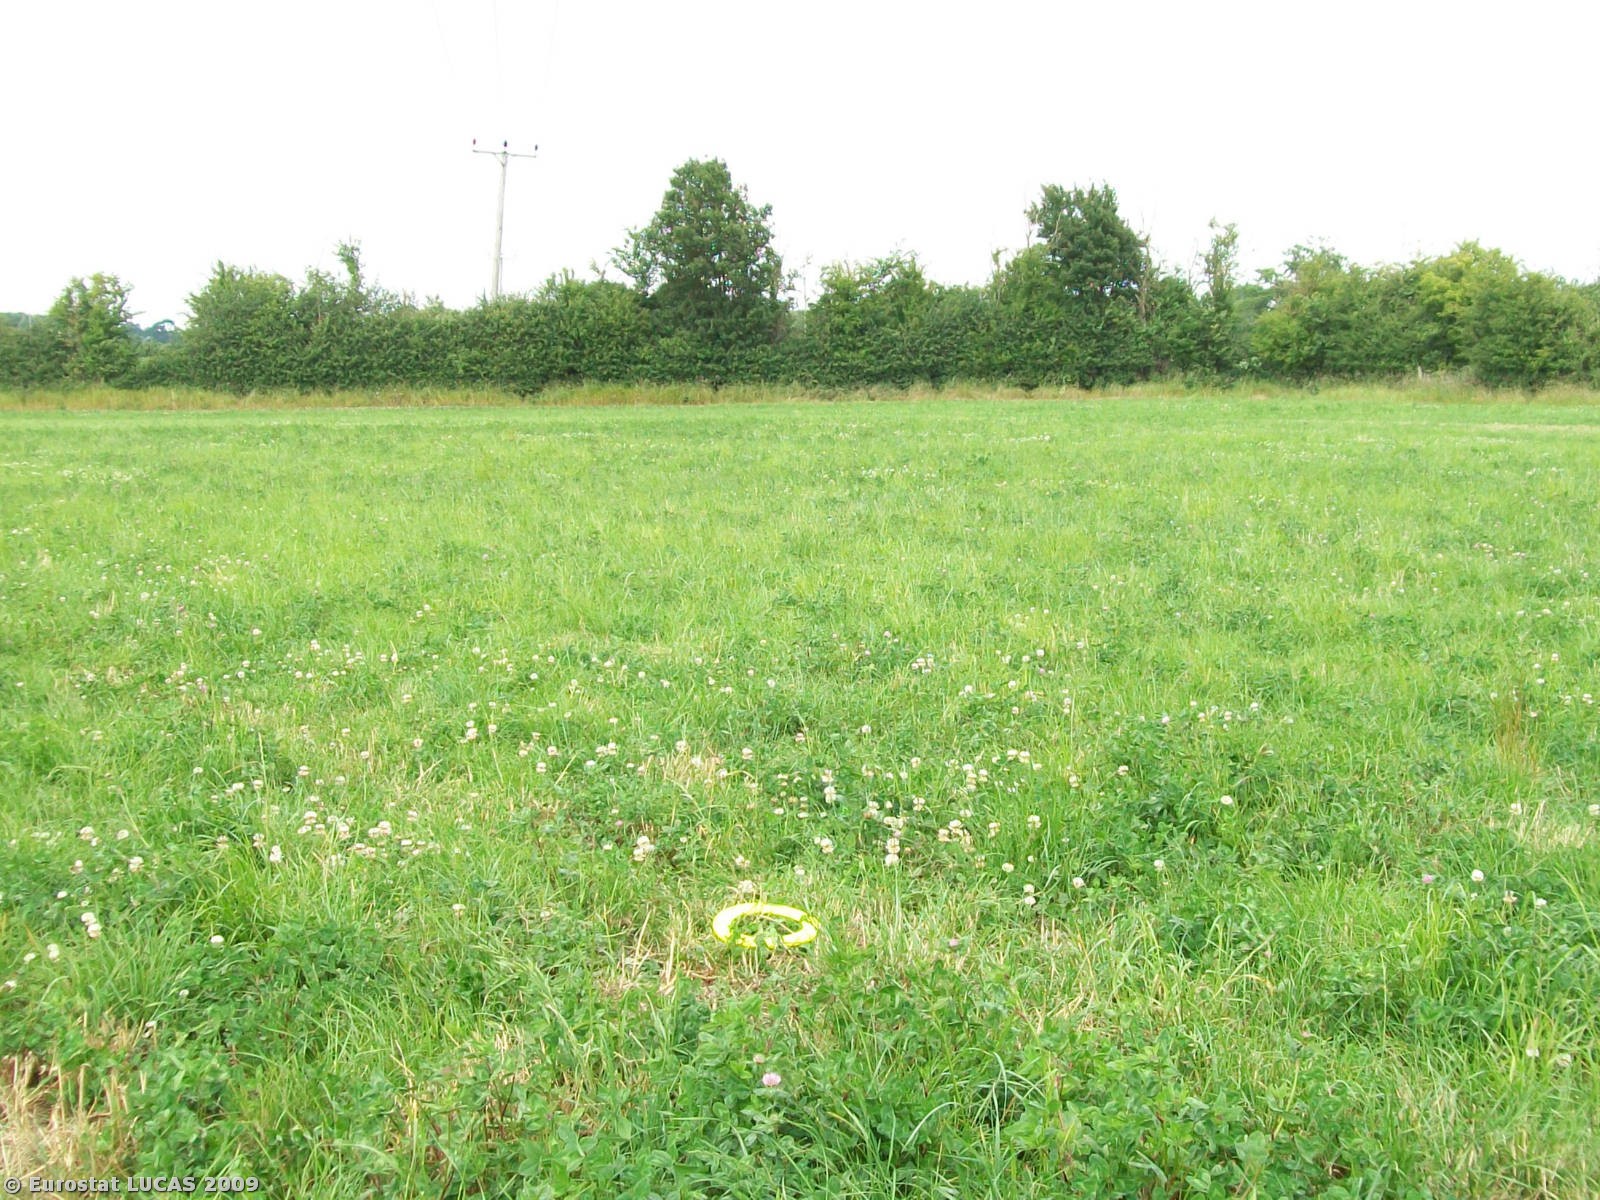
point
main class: Grassland
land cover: Grassland without tree/shrub cover
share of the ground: > 75 %
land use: Agriculture (excluding fallow land and kitchen gardens)
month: June
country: GB
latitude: 51.2838
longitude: -2.2639
